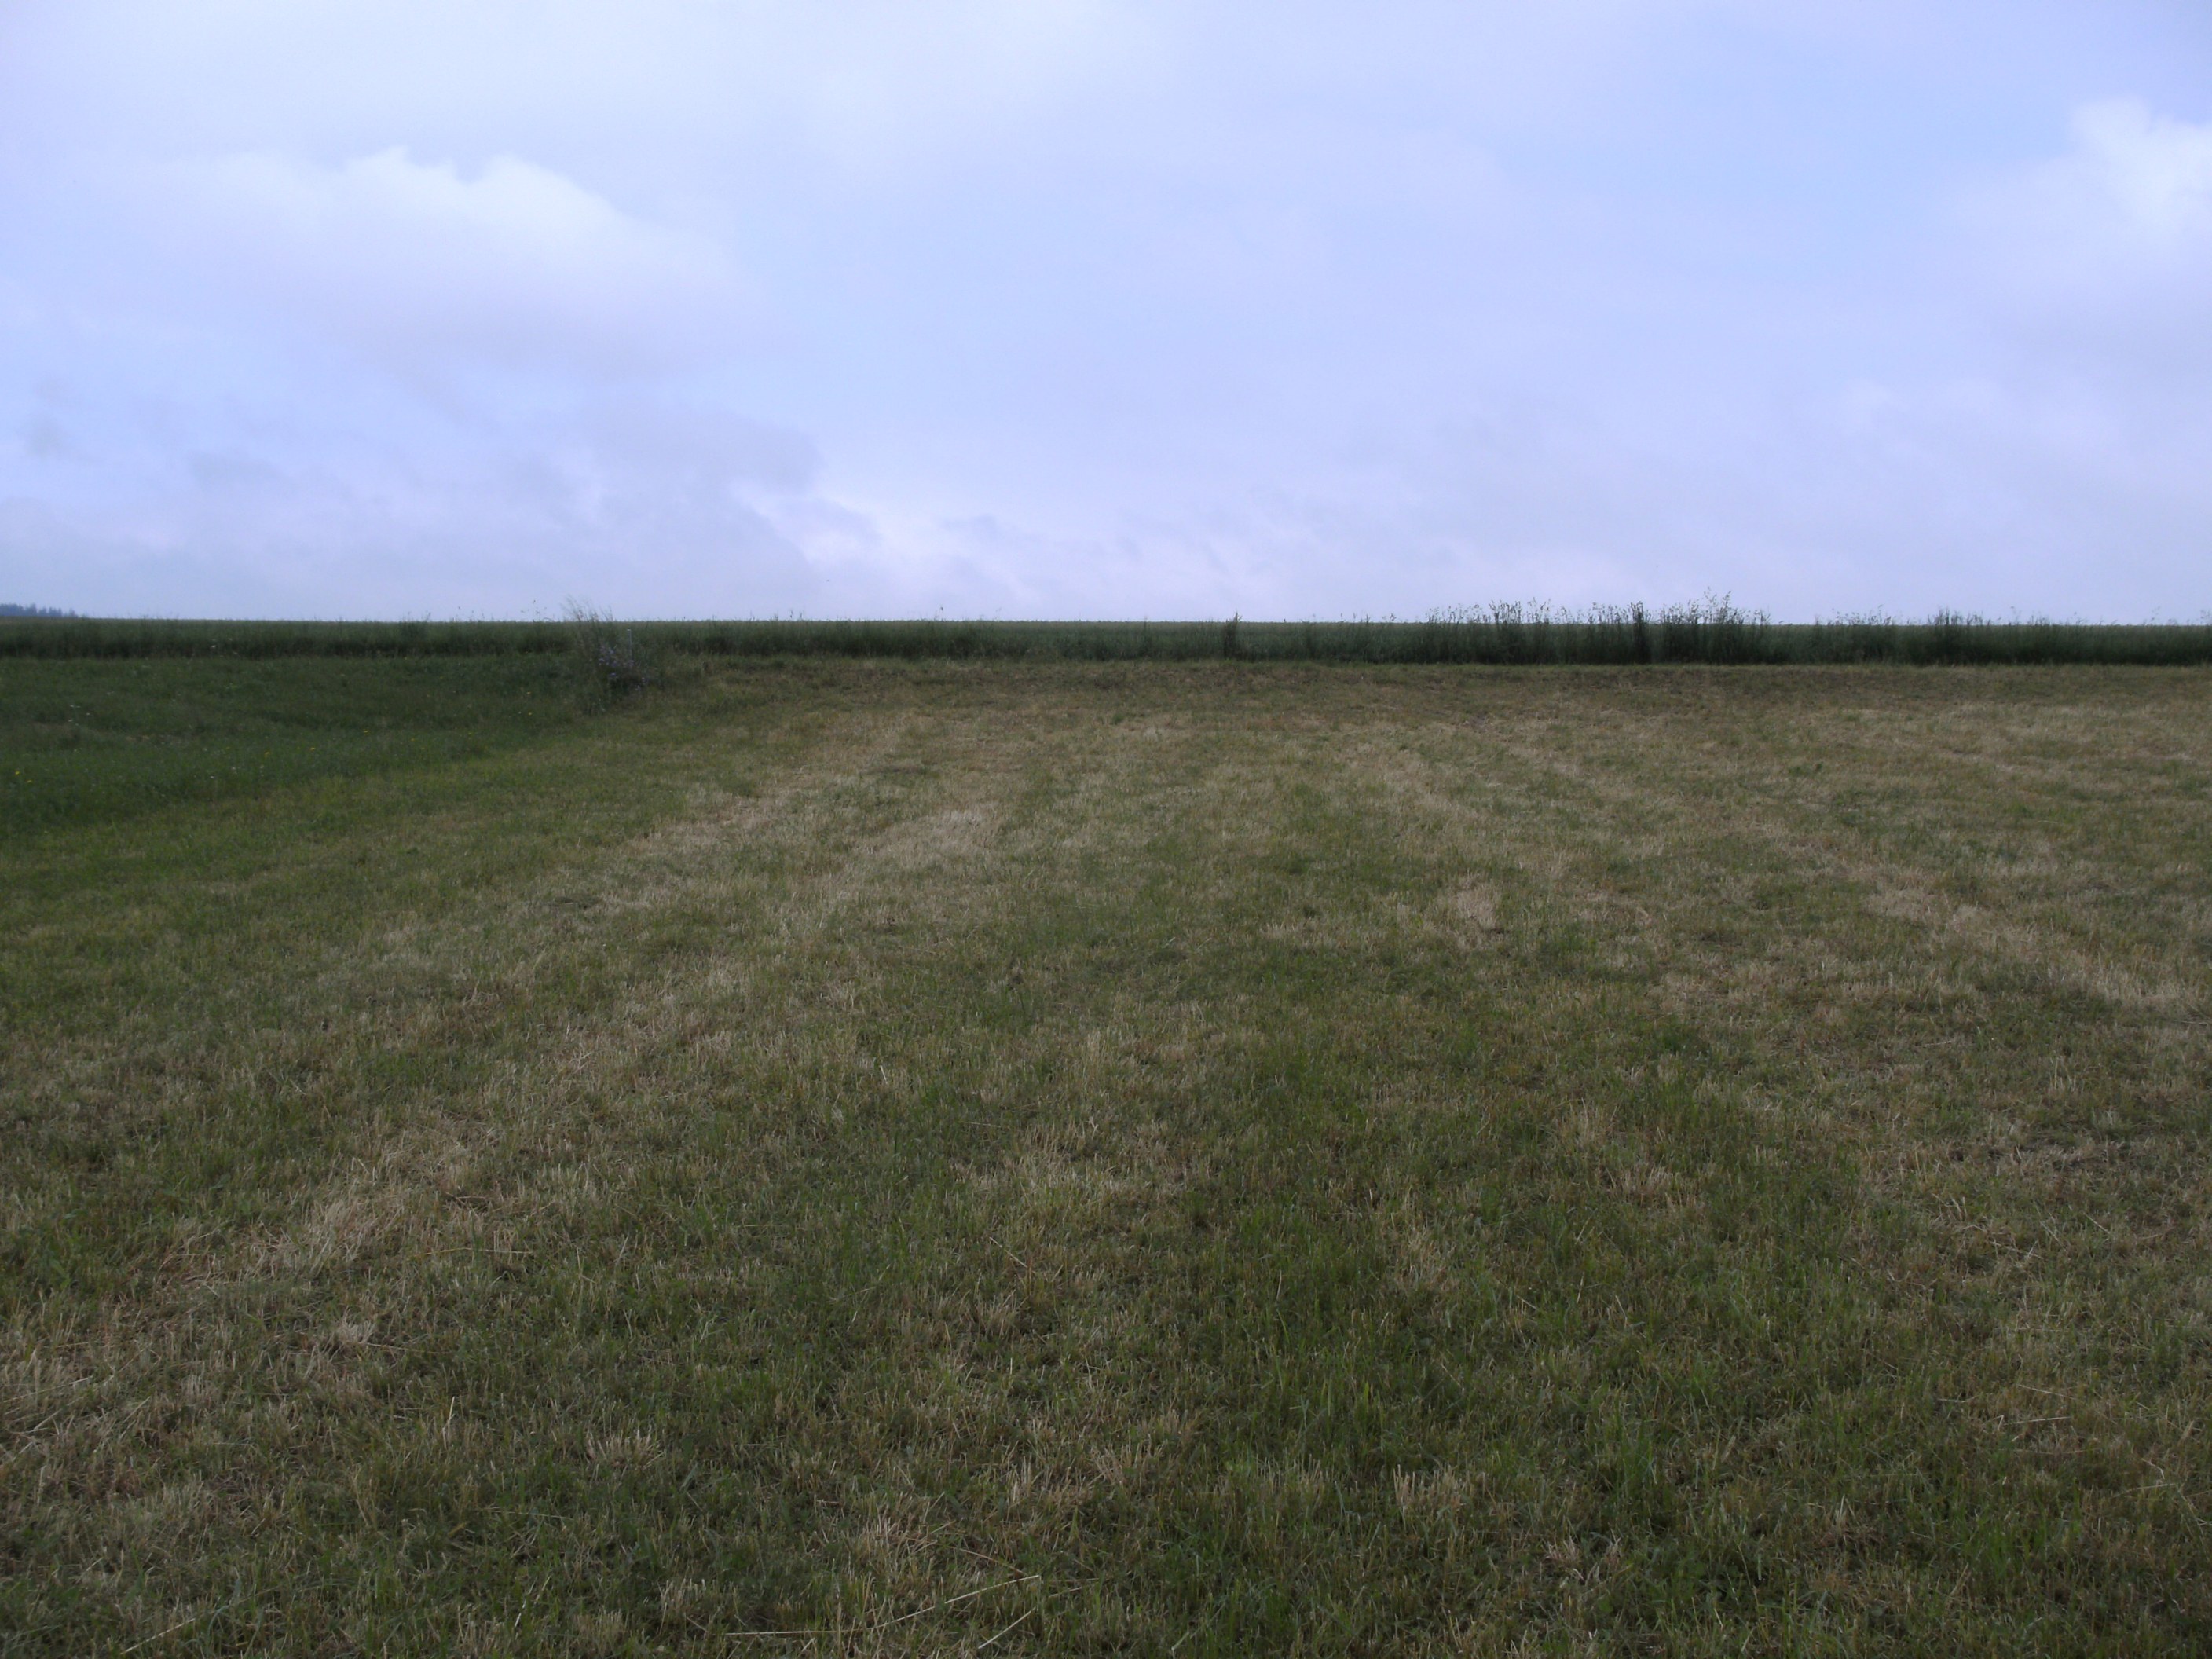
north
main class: Grassland
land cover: Grassland without tree/shrub cover
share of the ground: > 75 %
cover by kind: herbaceous plants 100 %
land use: Agriculture (excluding fallow land and kitchen gardens)
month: June
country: AT
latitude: 48.5004
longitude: 14.2906
